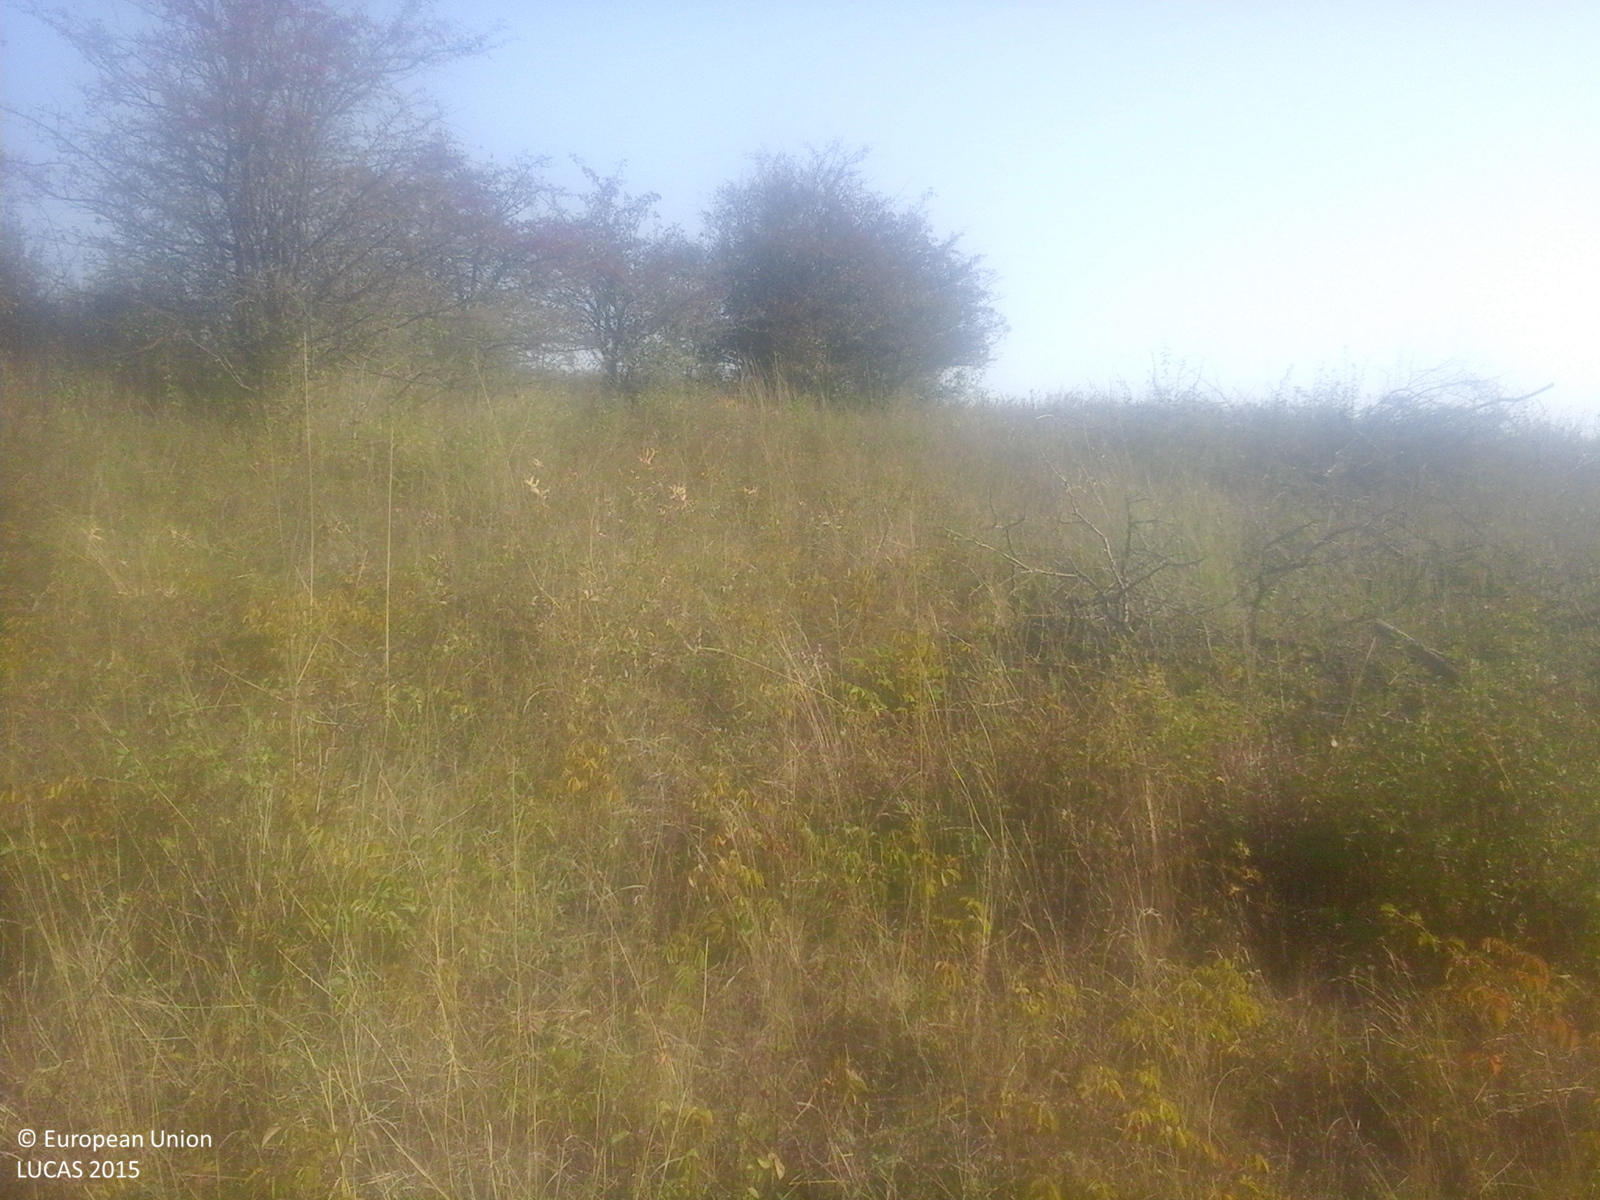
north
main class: Grassland
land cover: Grassland with sparse tree/shrub cover
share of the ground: > 75 %
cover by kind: herbaceous plants 85 %, shrubs 10 %, broadleaved forest trees 5 %
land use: Agriculture (excluding fallow land and kitchen gardens)
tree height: < 5 m
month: September
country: RO
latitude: 47.0349
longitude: 24.2584
